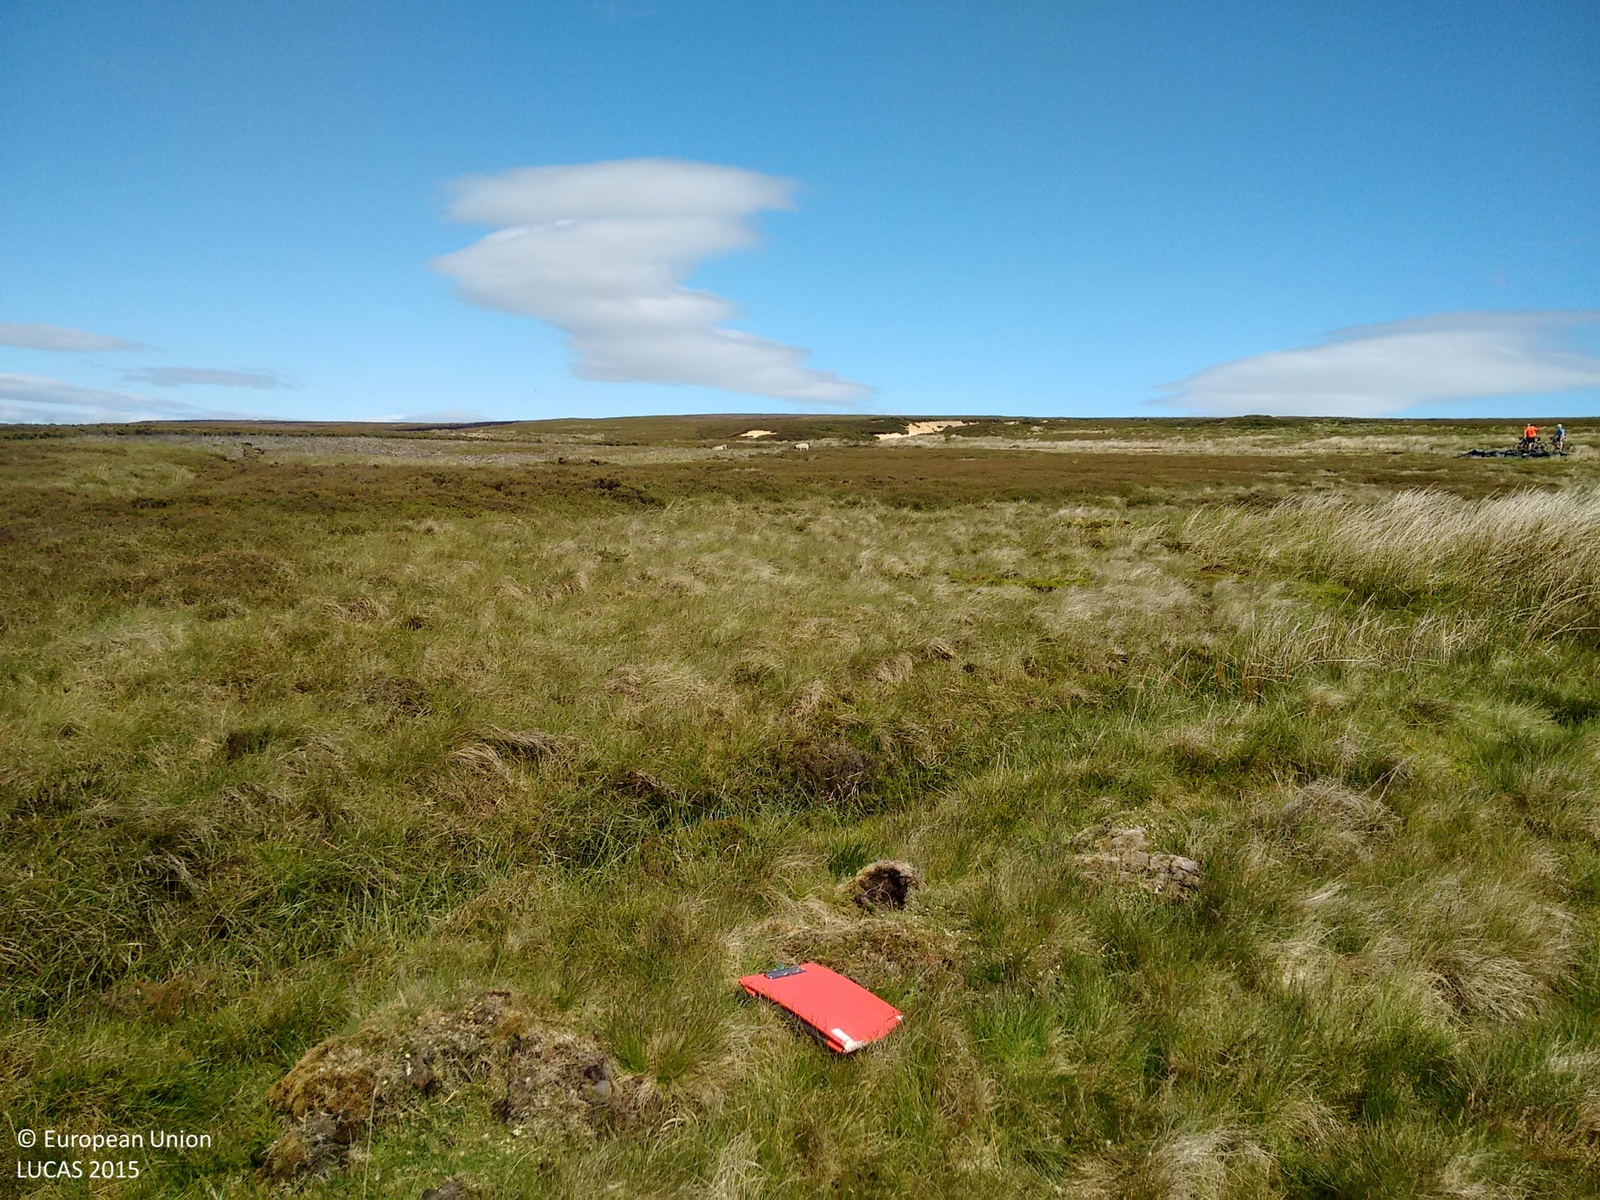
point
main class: Grassland
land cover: Grassland without tree/shrub cover
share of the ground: > 75 %
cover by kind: herbaceous plants 100 %
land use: Agriculture (excluding fallow land and kitchen gardens)
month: June
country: GB
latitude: 54.7986
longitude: -2.0488
